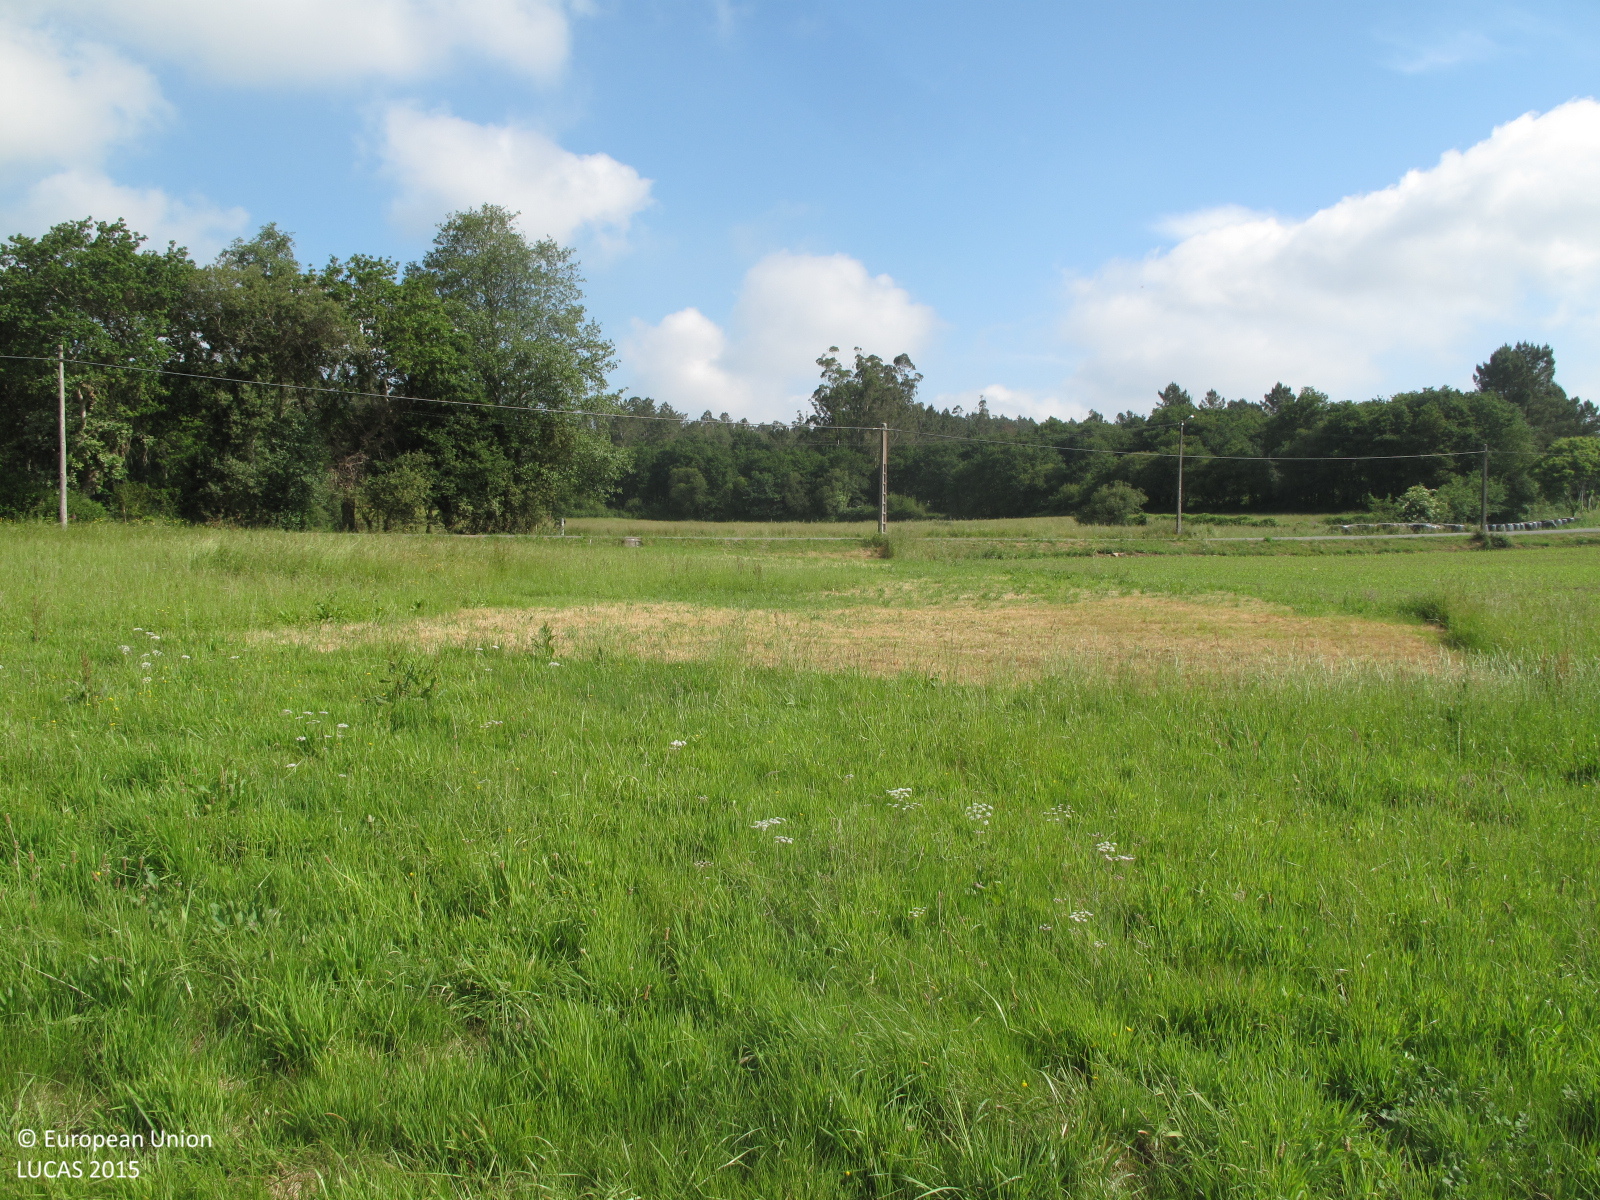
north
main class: Grassland
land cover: Grassland without tree/shrub cover
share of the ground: > 75 %
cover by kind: herbaceous plants 100 %
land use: Agriculture (excluding fallow land and kitchen gardens)
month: June
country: ES
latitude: 42.9374
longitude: -8.4472
